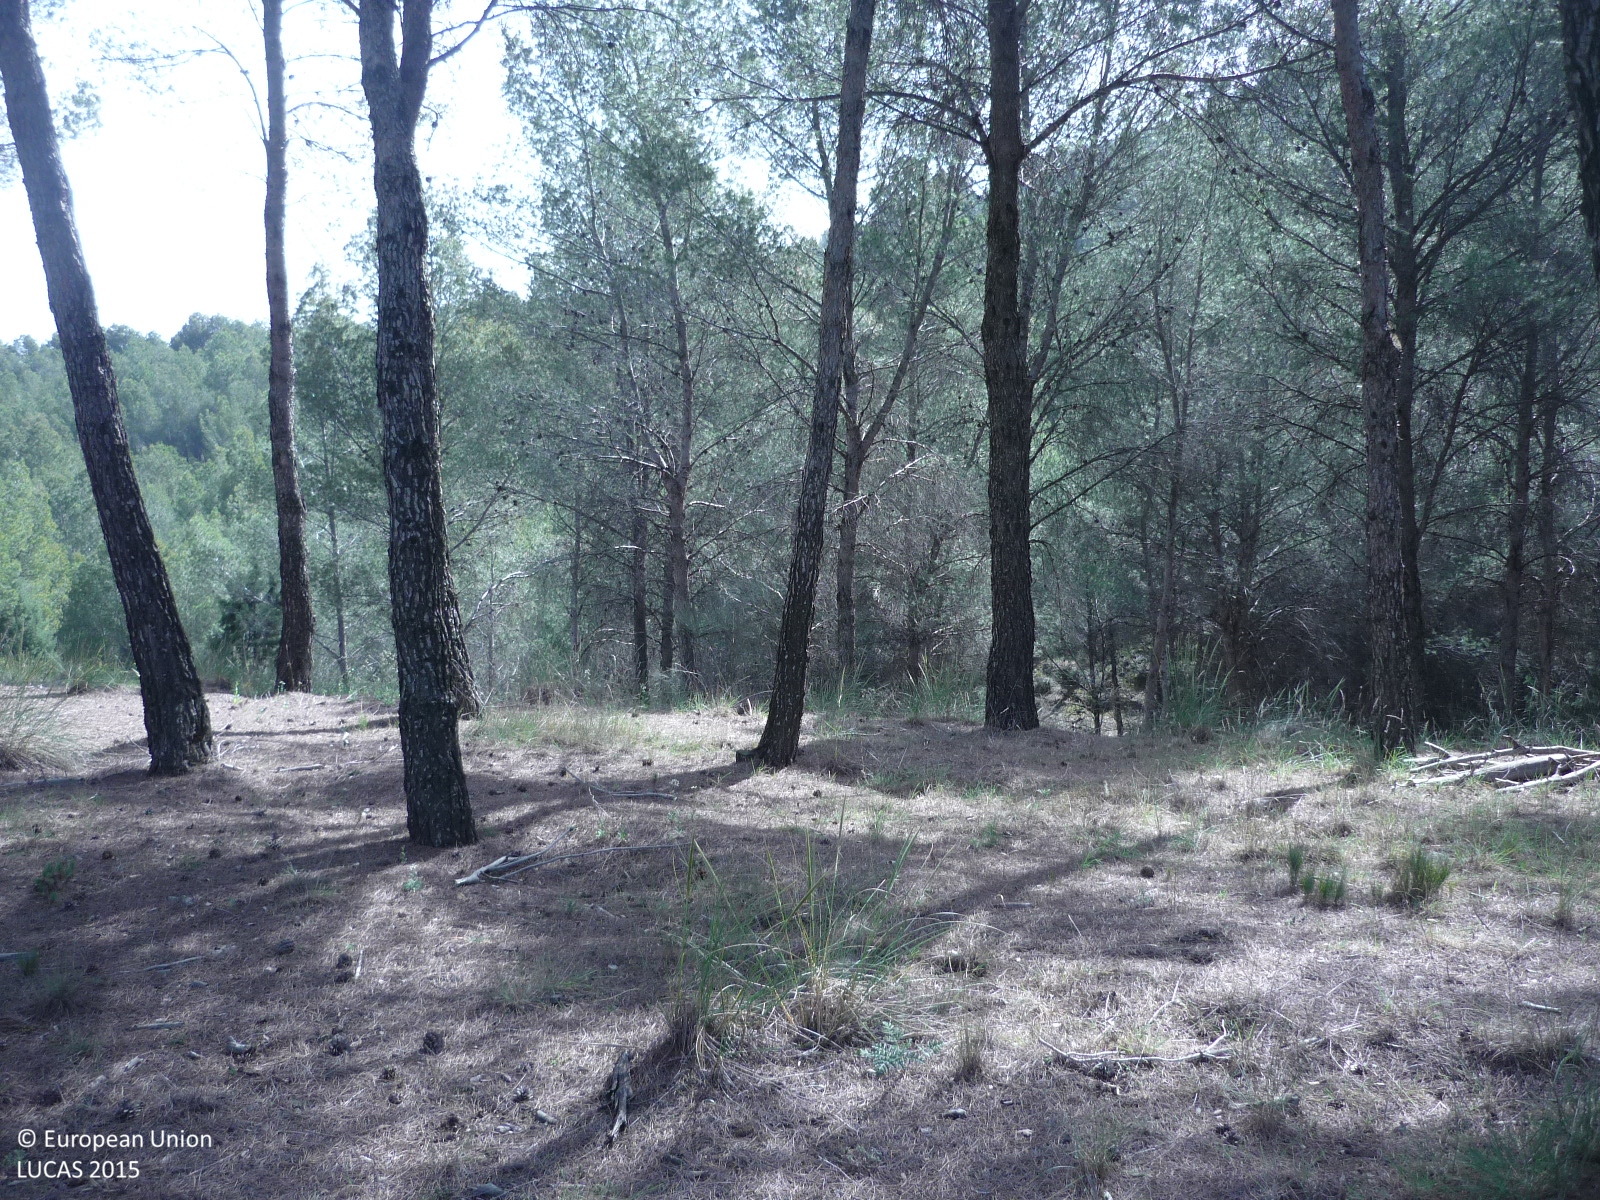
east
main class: Woodland
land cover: Pine dominated coniferous woodland
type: coniferous forest of the mediterranean region
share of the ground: > 75 %
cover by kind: coniferous forest trees 90 %, herbaceous plants 10 %
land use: Semi-natural and natural areas not in use
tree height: < 5 m
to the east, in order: Pine dominated coniferous woodland; Tracks; Pine dominated coniferous woodland; Tracks; Pine dominated coniferous woodland
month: April
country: ES
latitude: 40.4610
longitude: -3.3955
